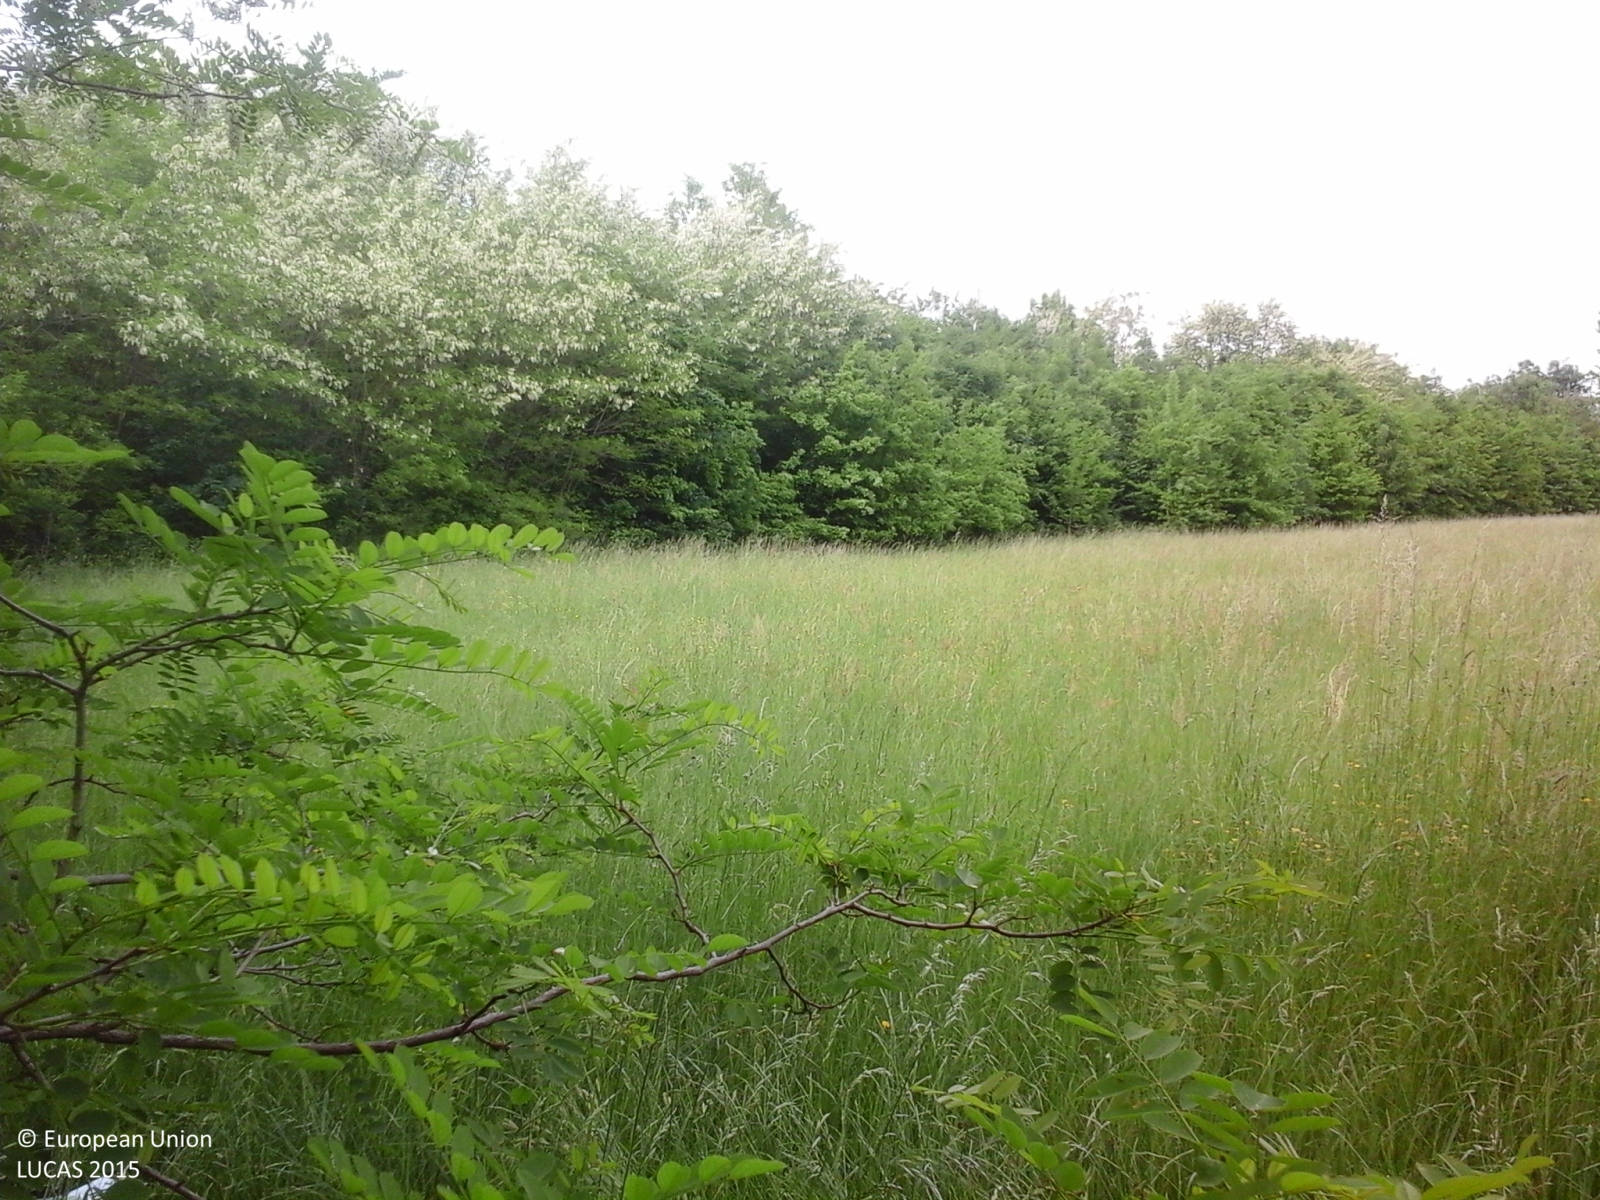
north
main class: Grassland
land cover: Grassland without tree/shrub cover
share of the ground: > 75 %
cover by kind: herbaceous plants 100 %
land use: Agriculture (excluding fallow land and kitchen gardens)
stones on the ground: < 10 %
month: May
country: IT
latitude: 45.6541
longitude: 8.3728
